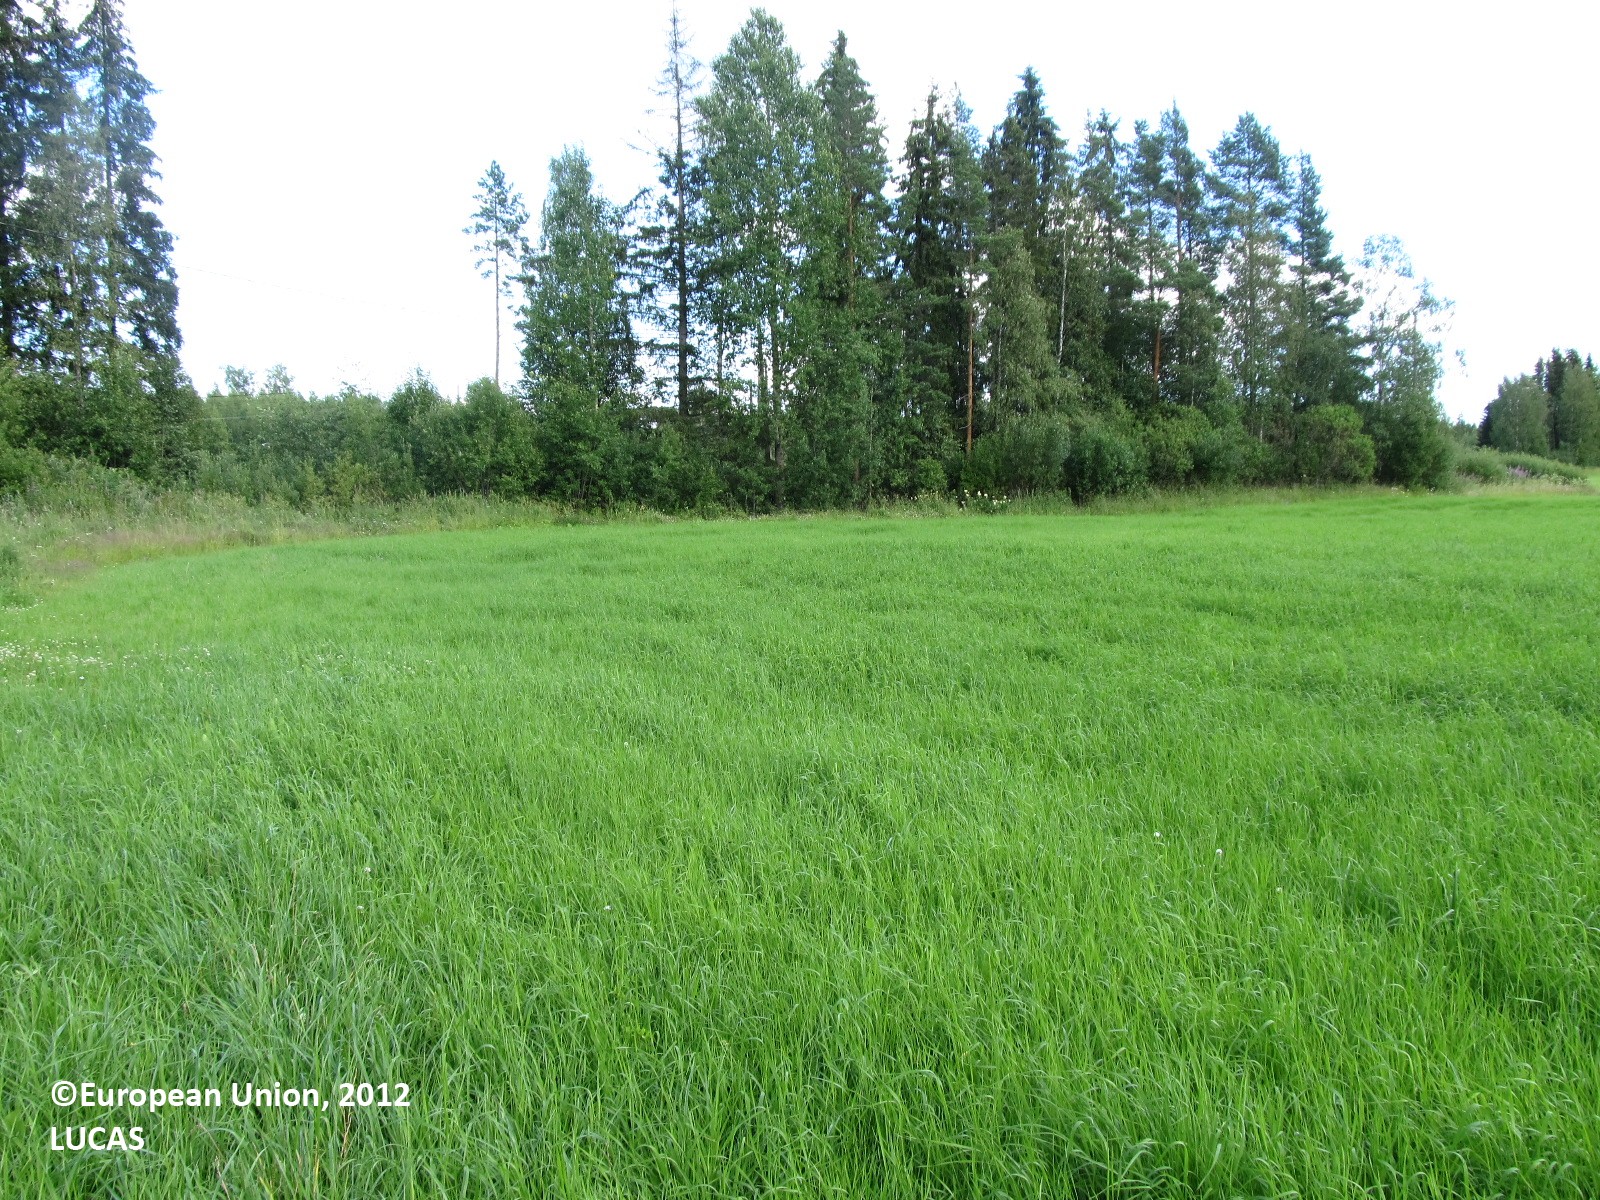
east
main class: Cropland
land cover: Temporary grasslands
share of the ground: > 75 %
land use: Agriculture (excluding fallow land and kitchen gardens)
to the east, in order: Temporary grasslands; Ditches and canals; Spruce dominated coniferous woodland; Ditches and canals; Oats
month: July
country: FI
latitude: 62.0154
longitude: 28.2900
